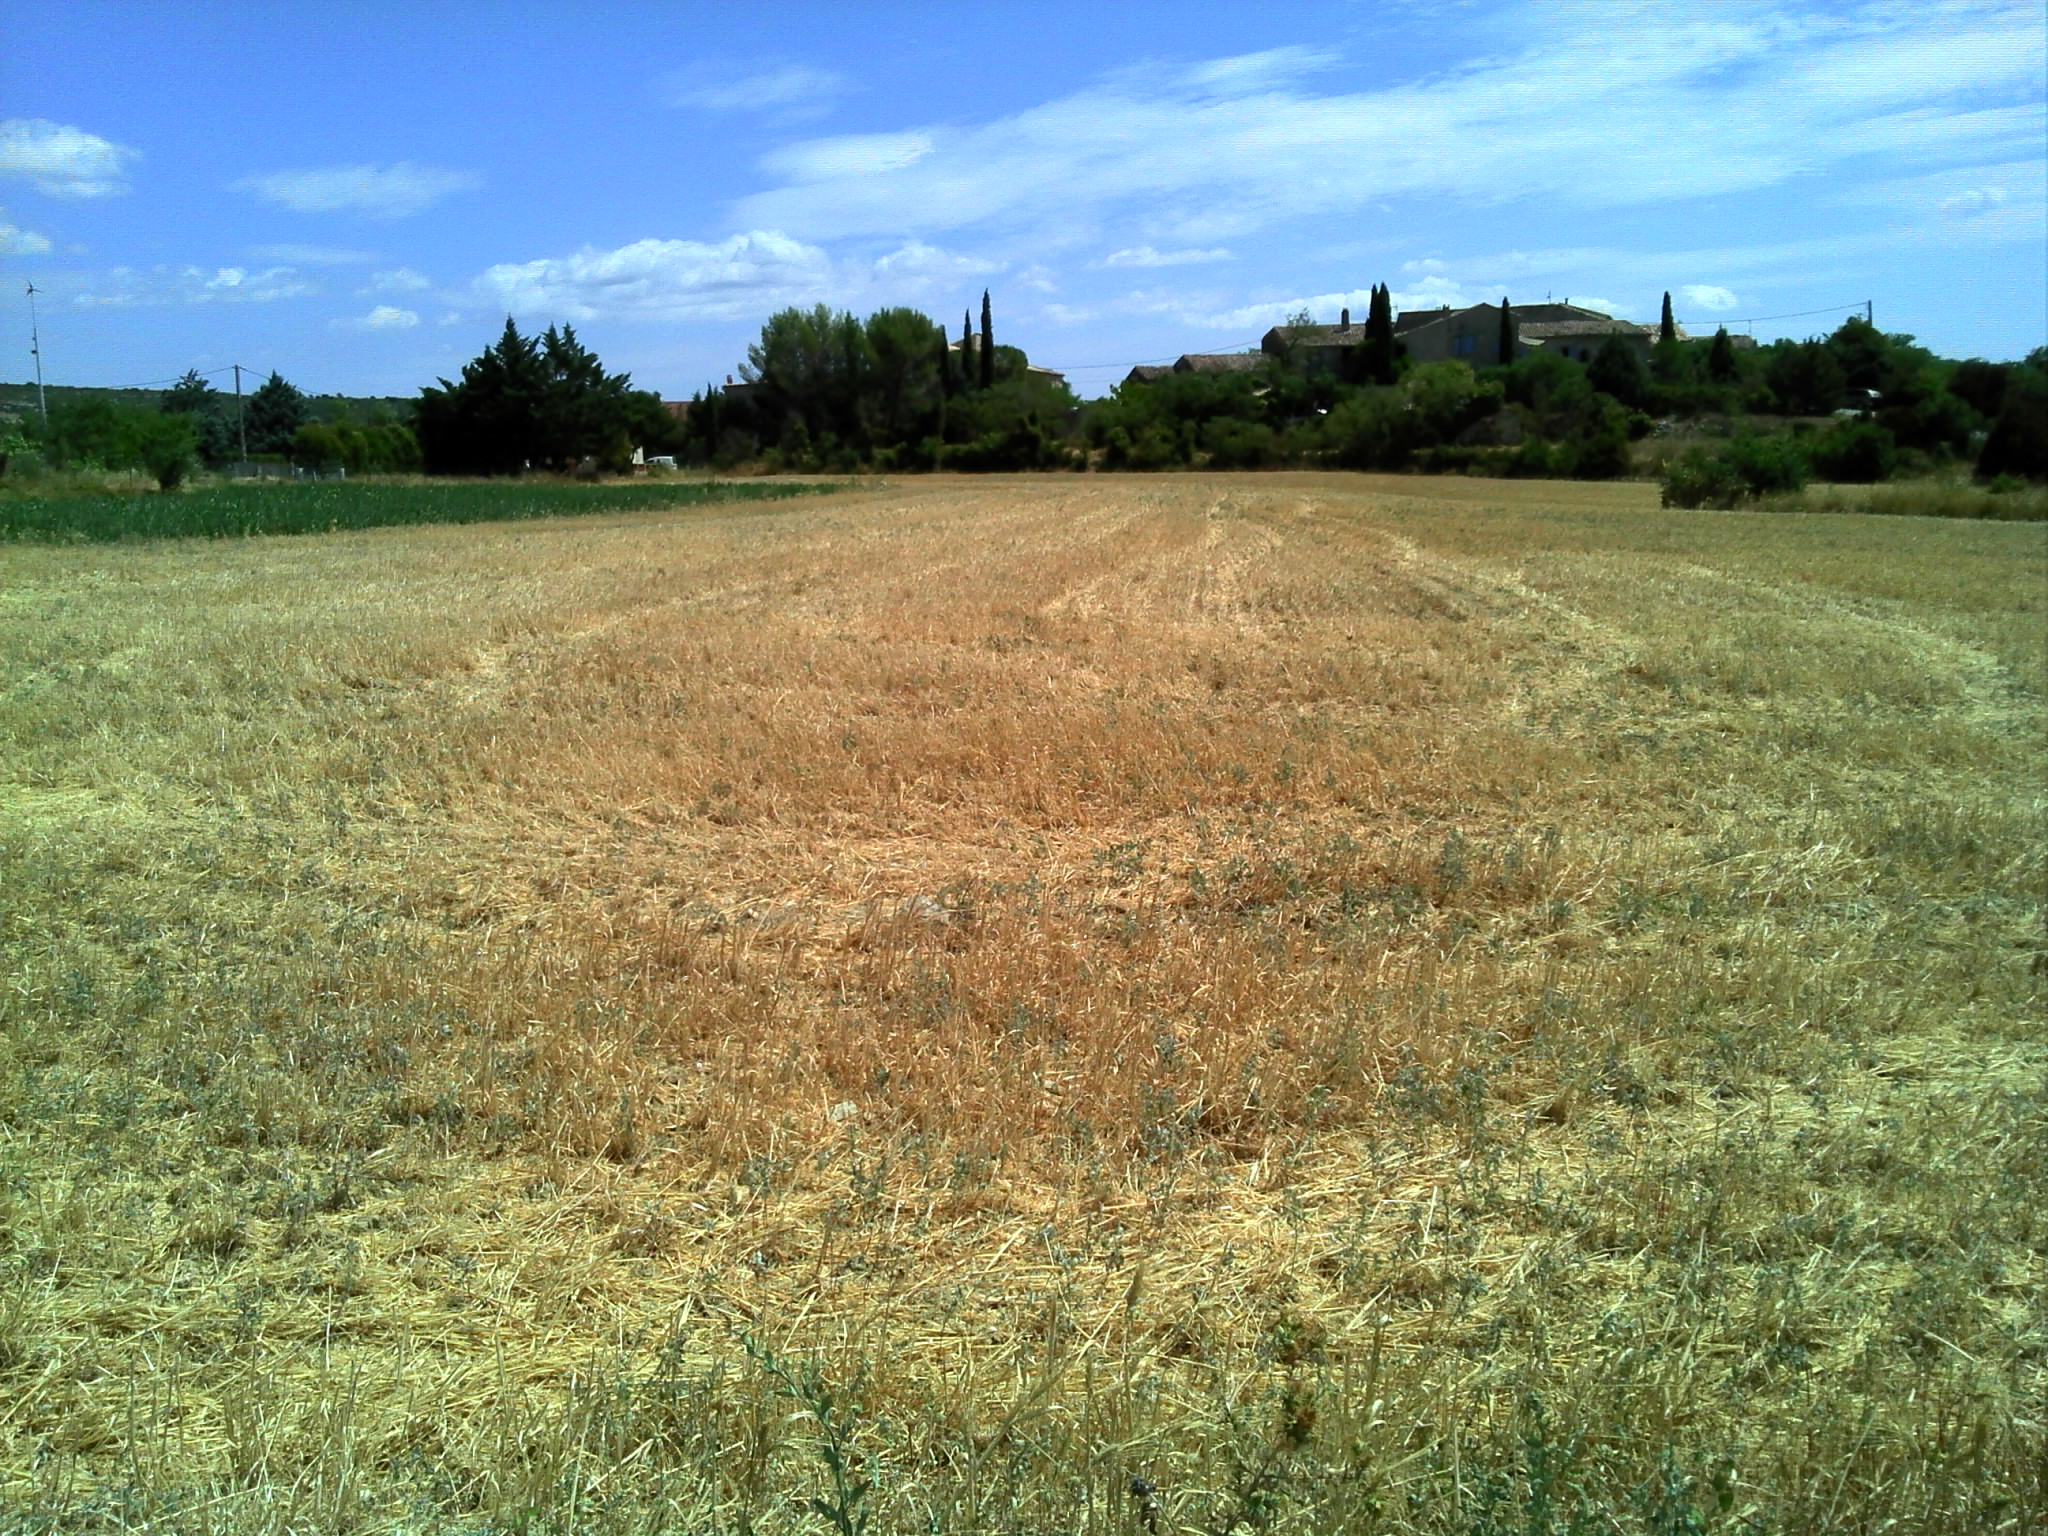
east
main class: Cropland
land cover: Durum wheat
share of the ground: 10 - 25 %
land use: Agriculture (excluding fallow land and kitchen gardens)
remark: Harvested field
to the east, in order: Ditches and canals; Grass margins; Durum wheat; Spontaneously vegetated surfaces; Abandoned hedges; Tracks; Broadleaved woodland; Artificial constructions in urban areas
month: July
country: FR
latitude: 44.0882
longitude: 4.3502
